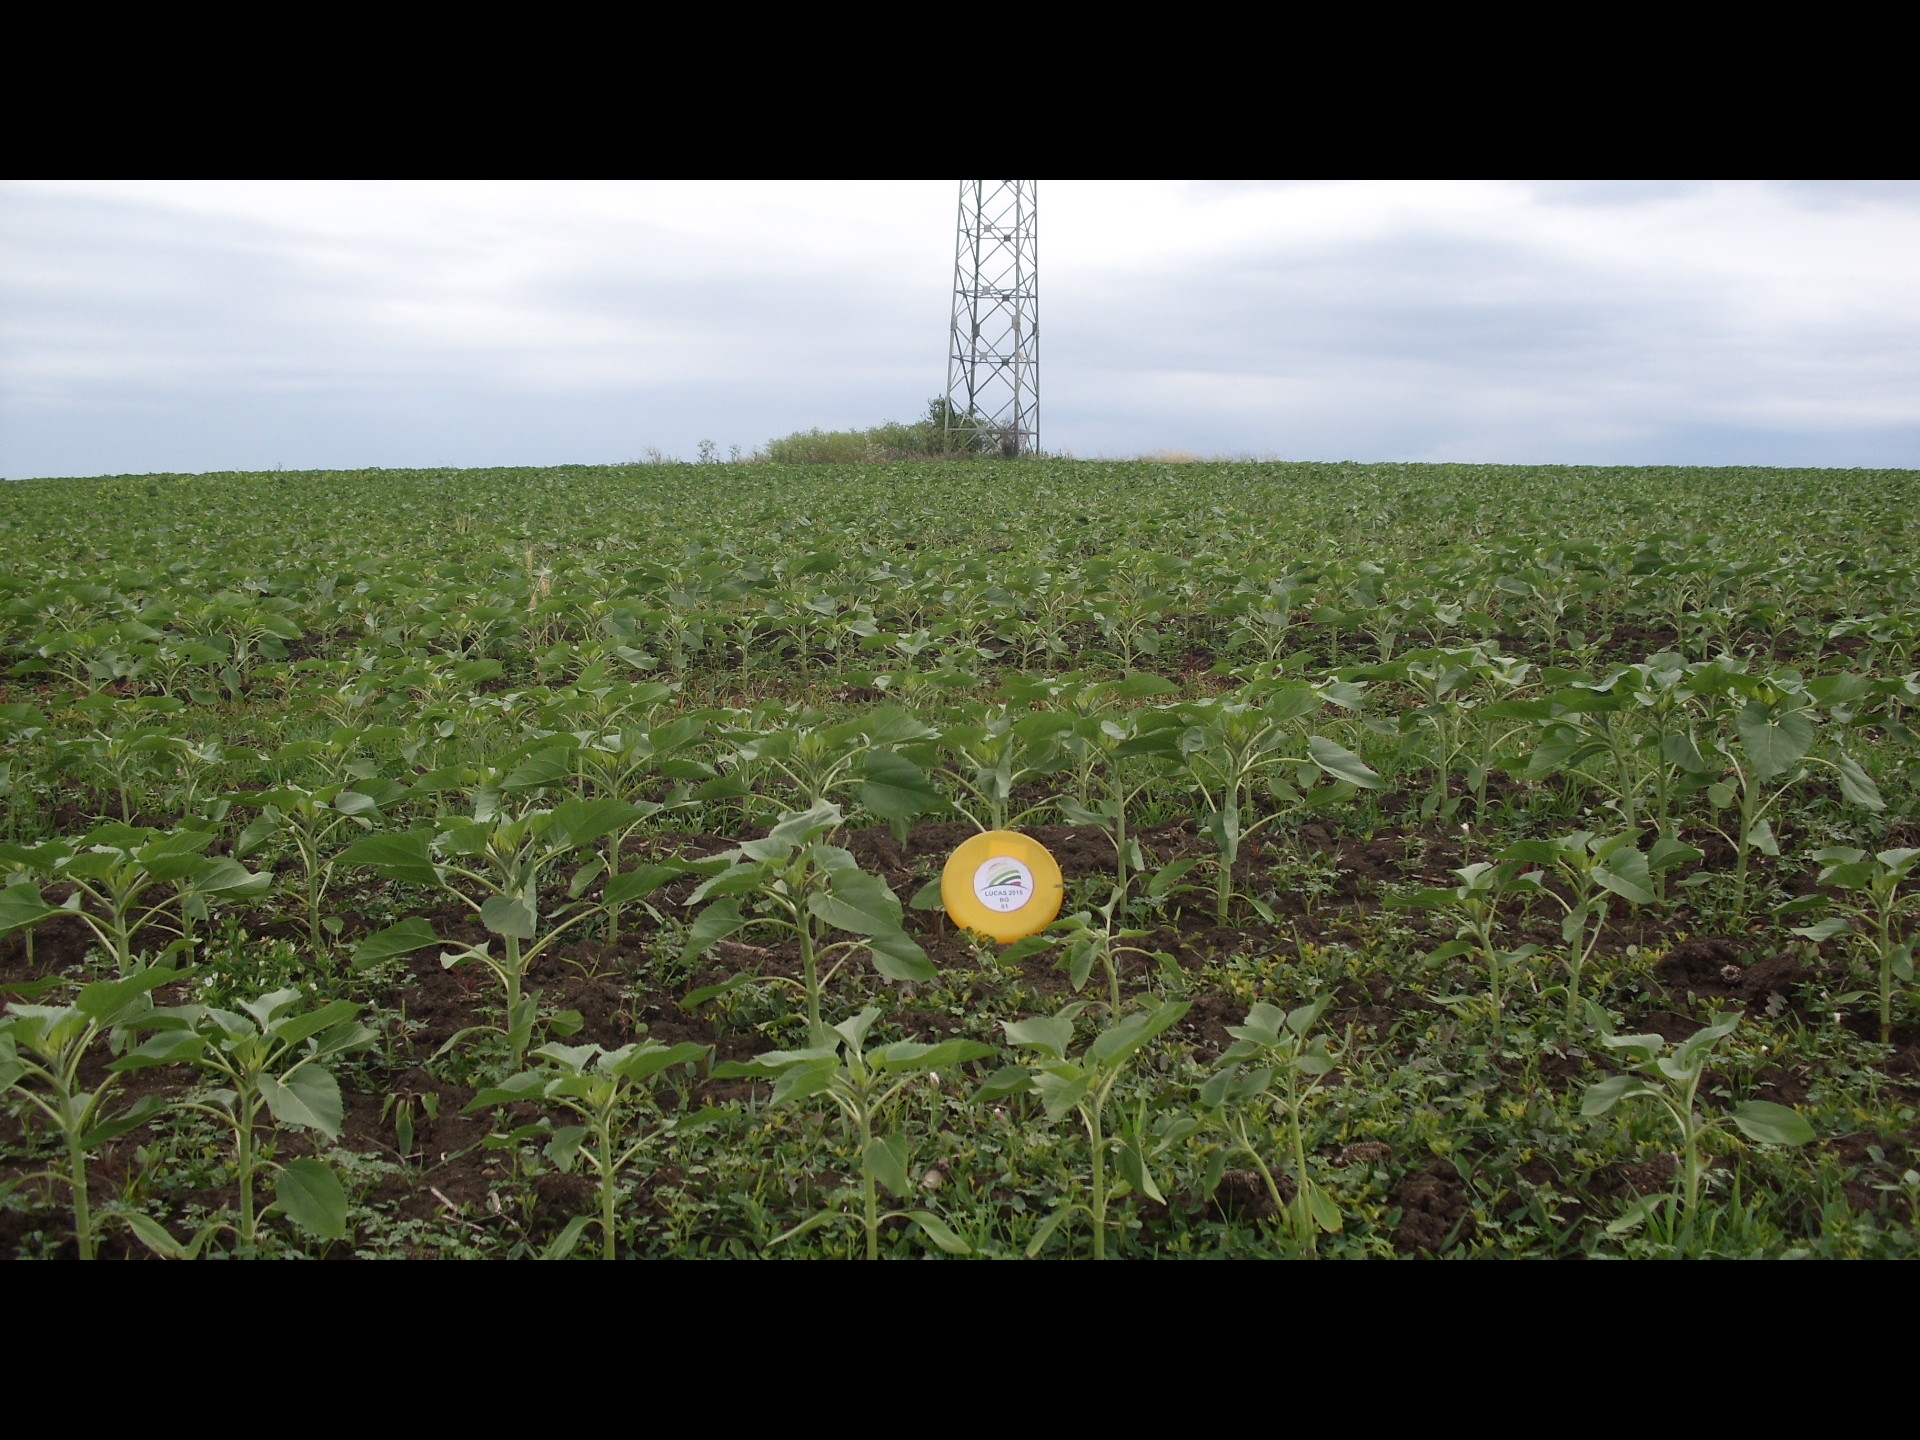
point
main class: Cropland
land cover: Sunflower
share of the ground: 25 - 50 %
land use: Agriculture (excluding fallow land and kitchen gardens)
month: June
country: BG
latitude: 43.4422
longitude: 23.5245
